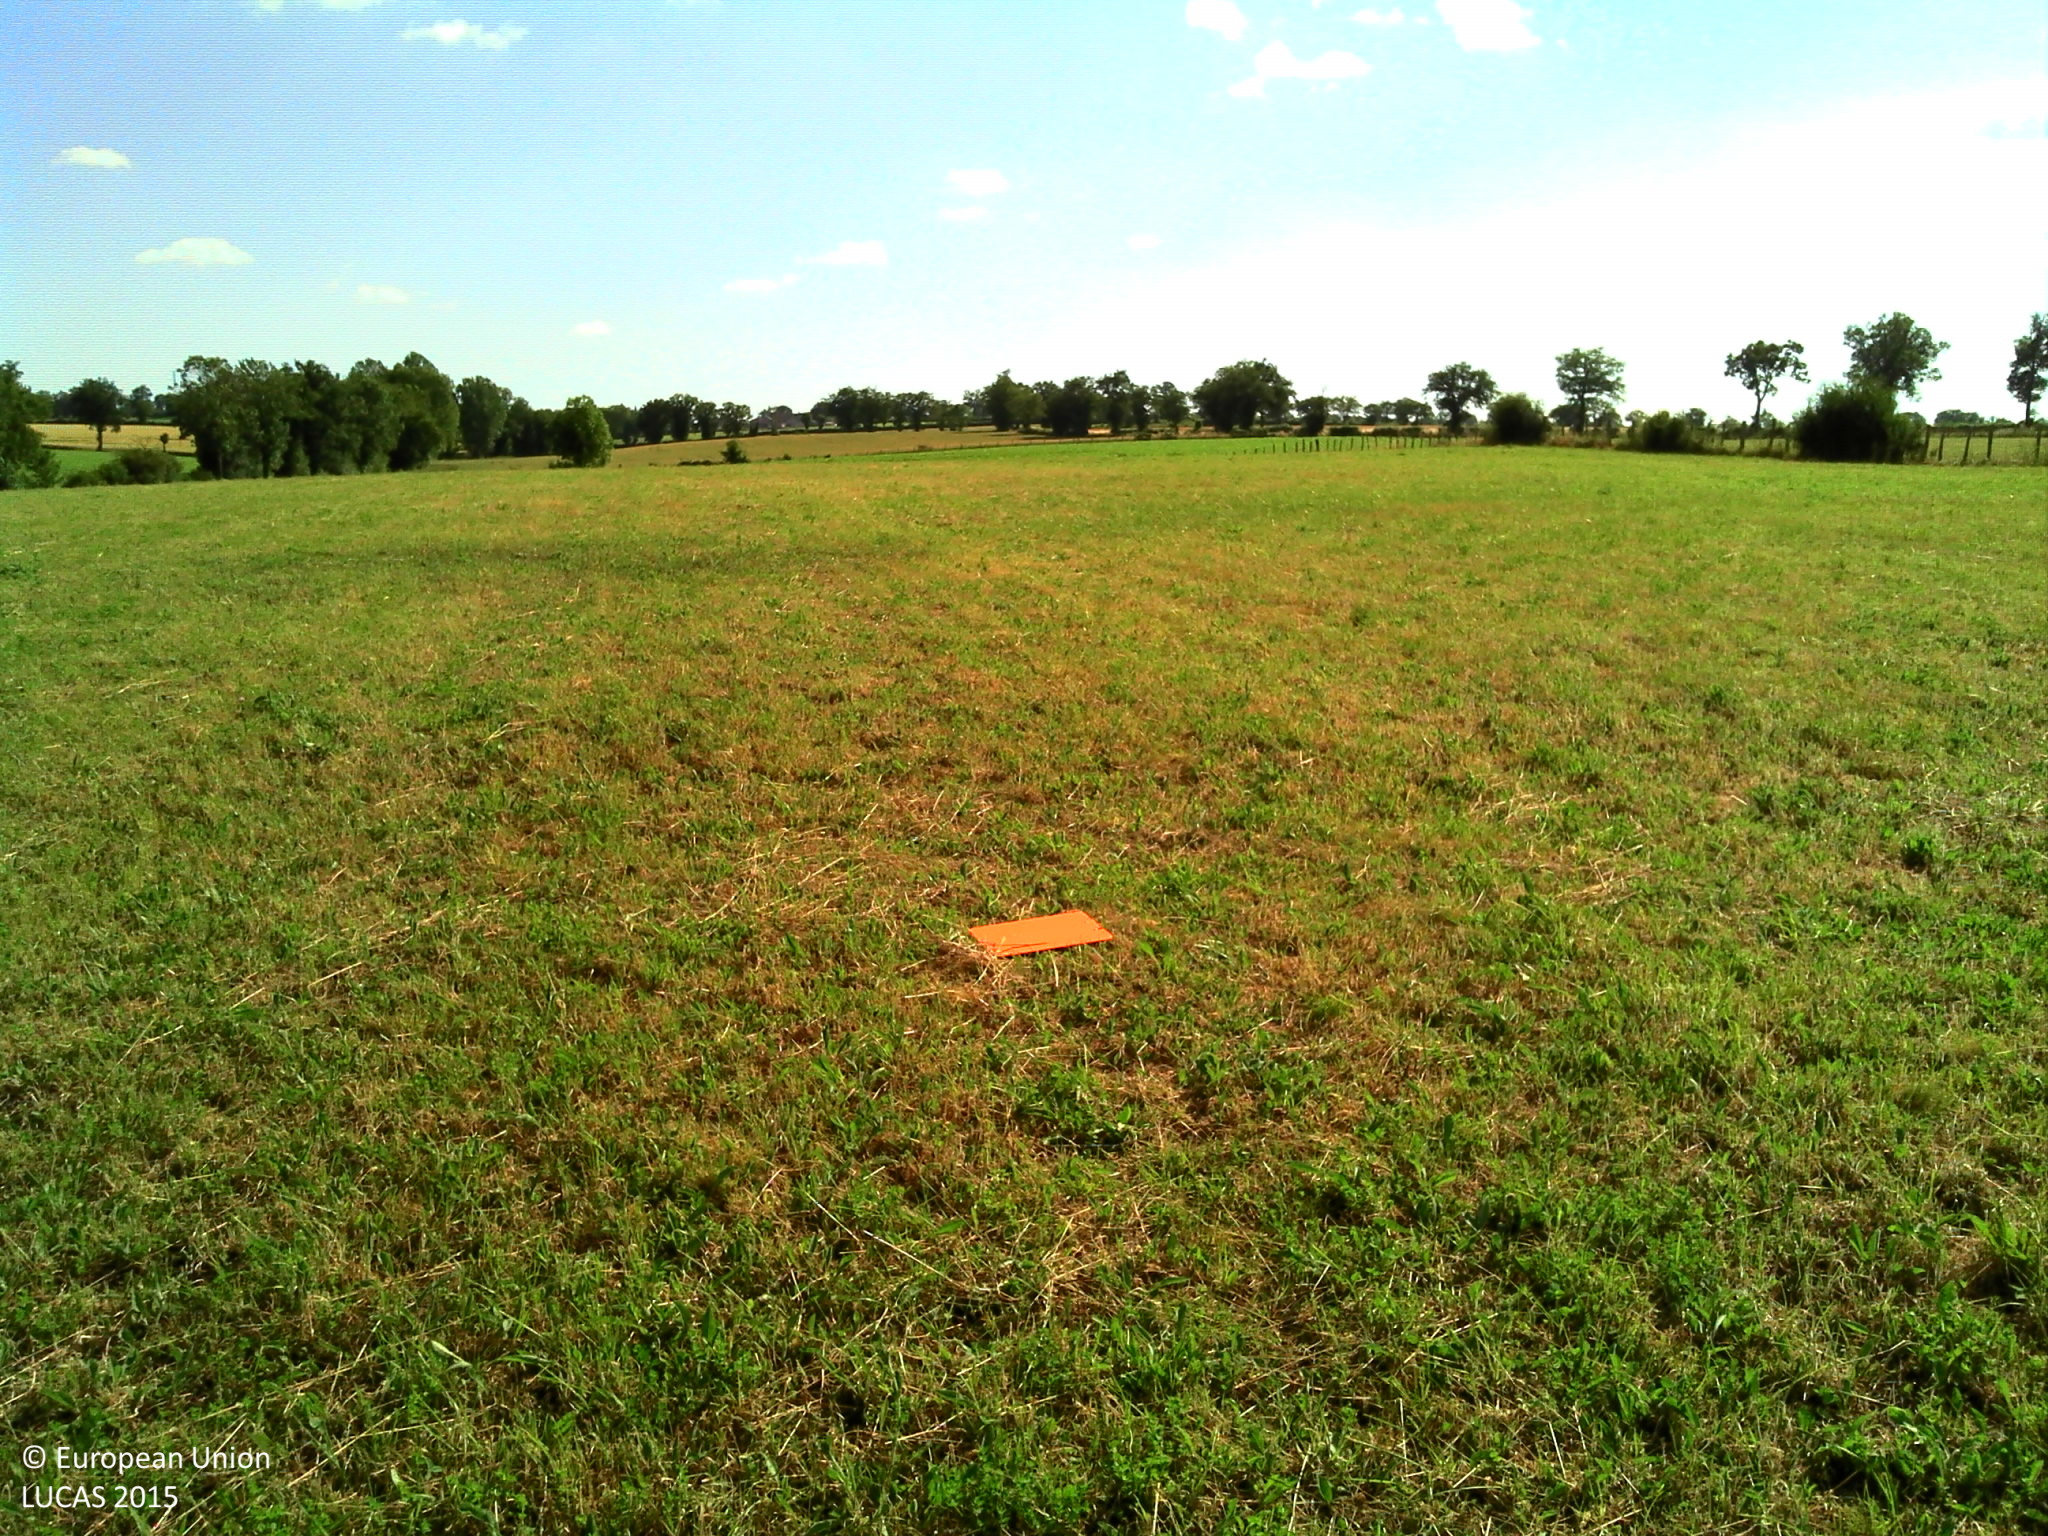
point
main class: Grassland
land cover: Grassland without tree/shrub cover
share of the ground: > 75 %
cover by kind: herbaceous plants 100 %
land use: Agriculture (excluding fallow land and kitchen gardens)
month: June
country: FR
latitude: 44.3676
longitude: 2.4864
